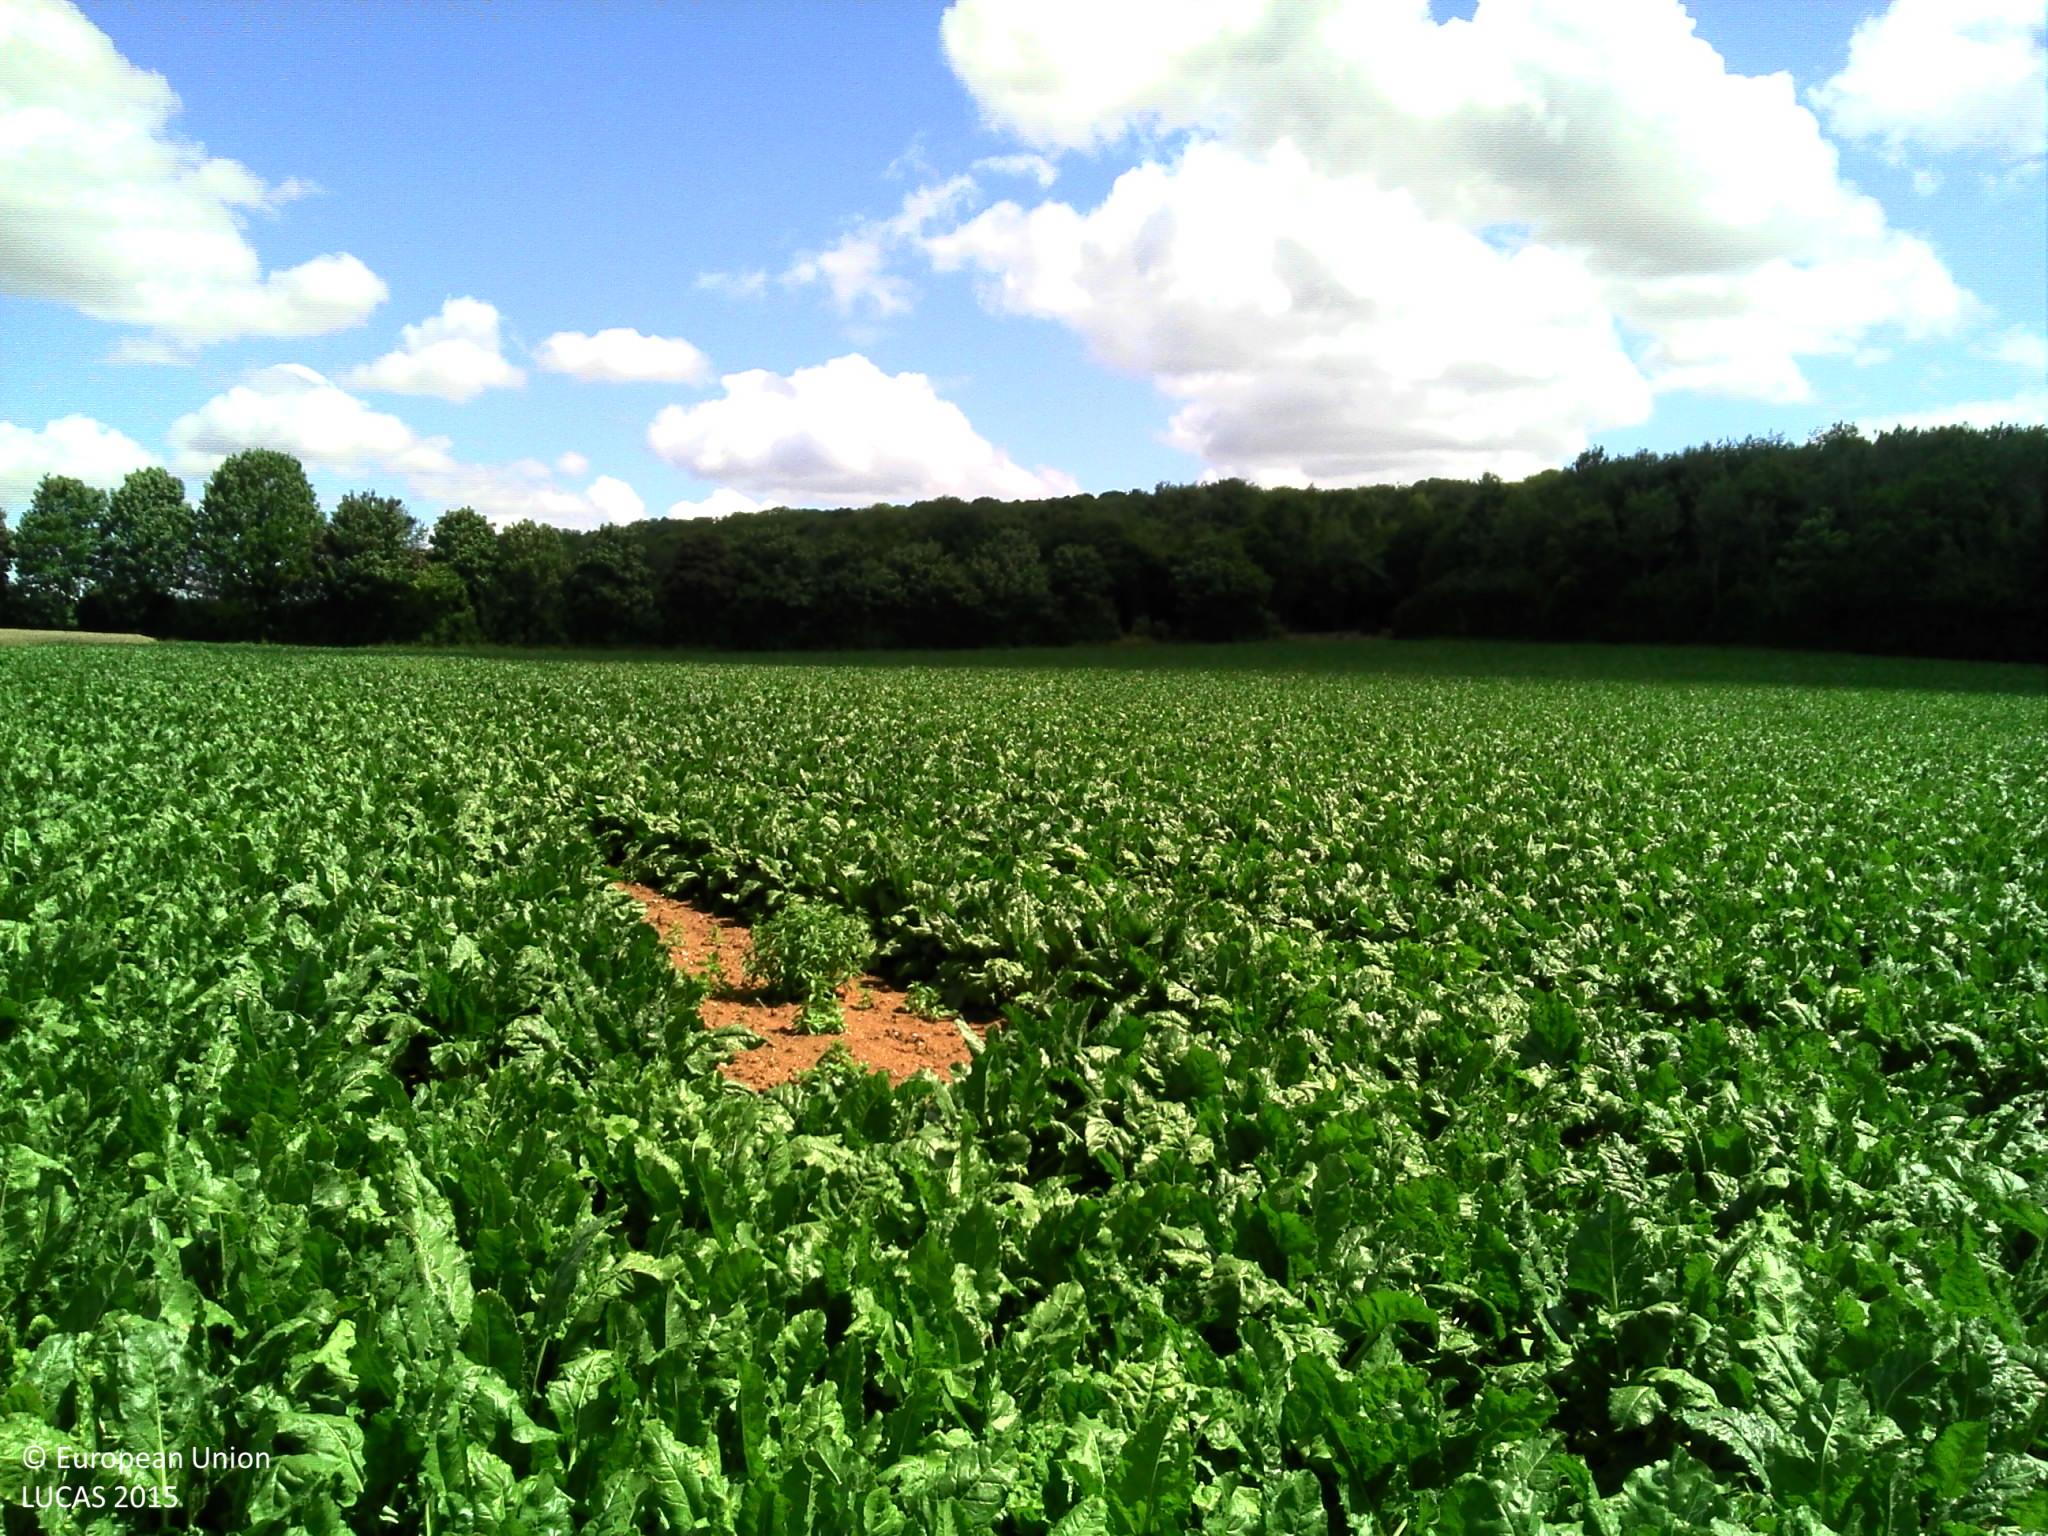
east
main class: Cropland
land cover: Sugar beet
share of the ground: > 75 %
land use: Agriculture (excluding fallow land and kitchen gardens)
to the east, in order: Sugar beet; Lines of trees; Grass margins; Tracks; Grass margins; Fences; Broadleaved woodland
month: July
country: FR
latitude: 50.0052
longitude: 2.4389
